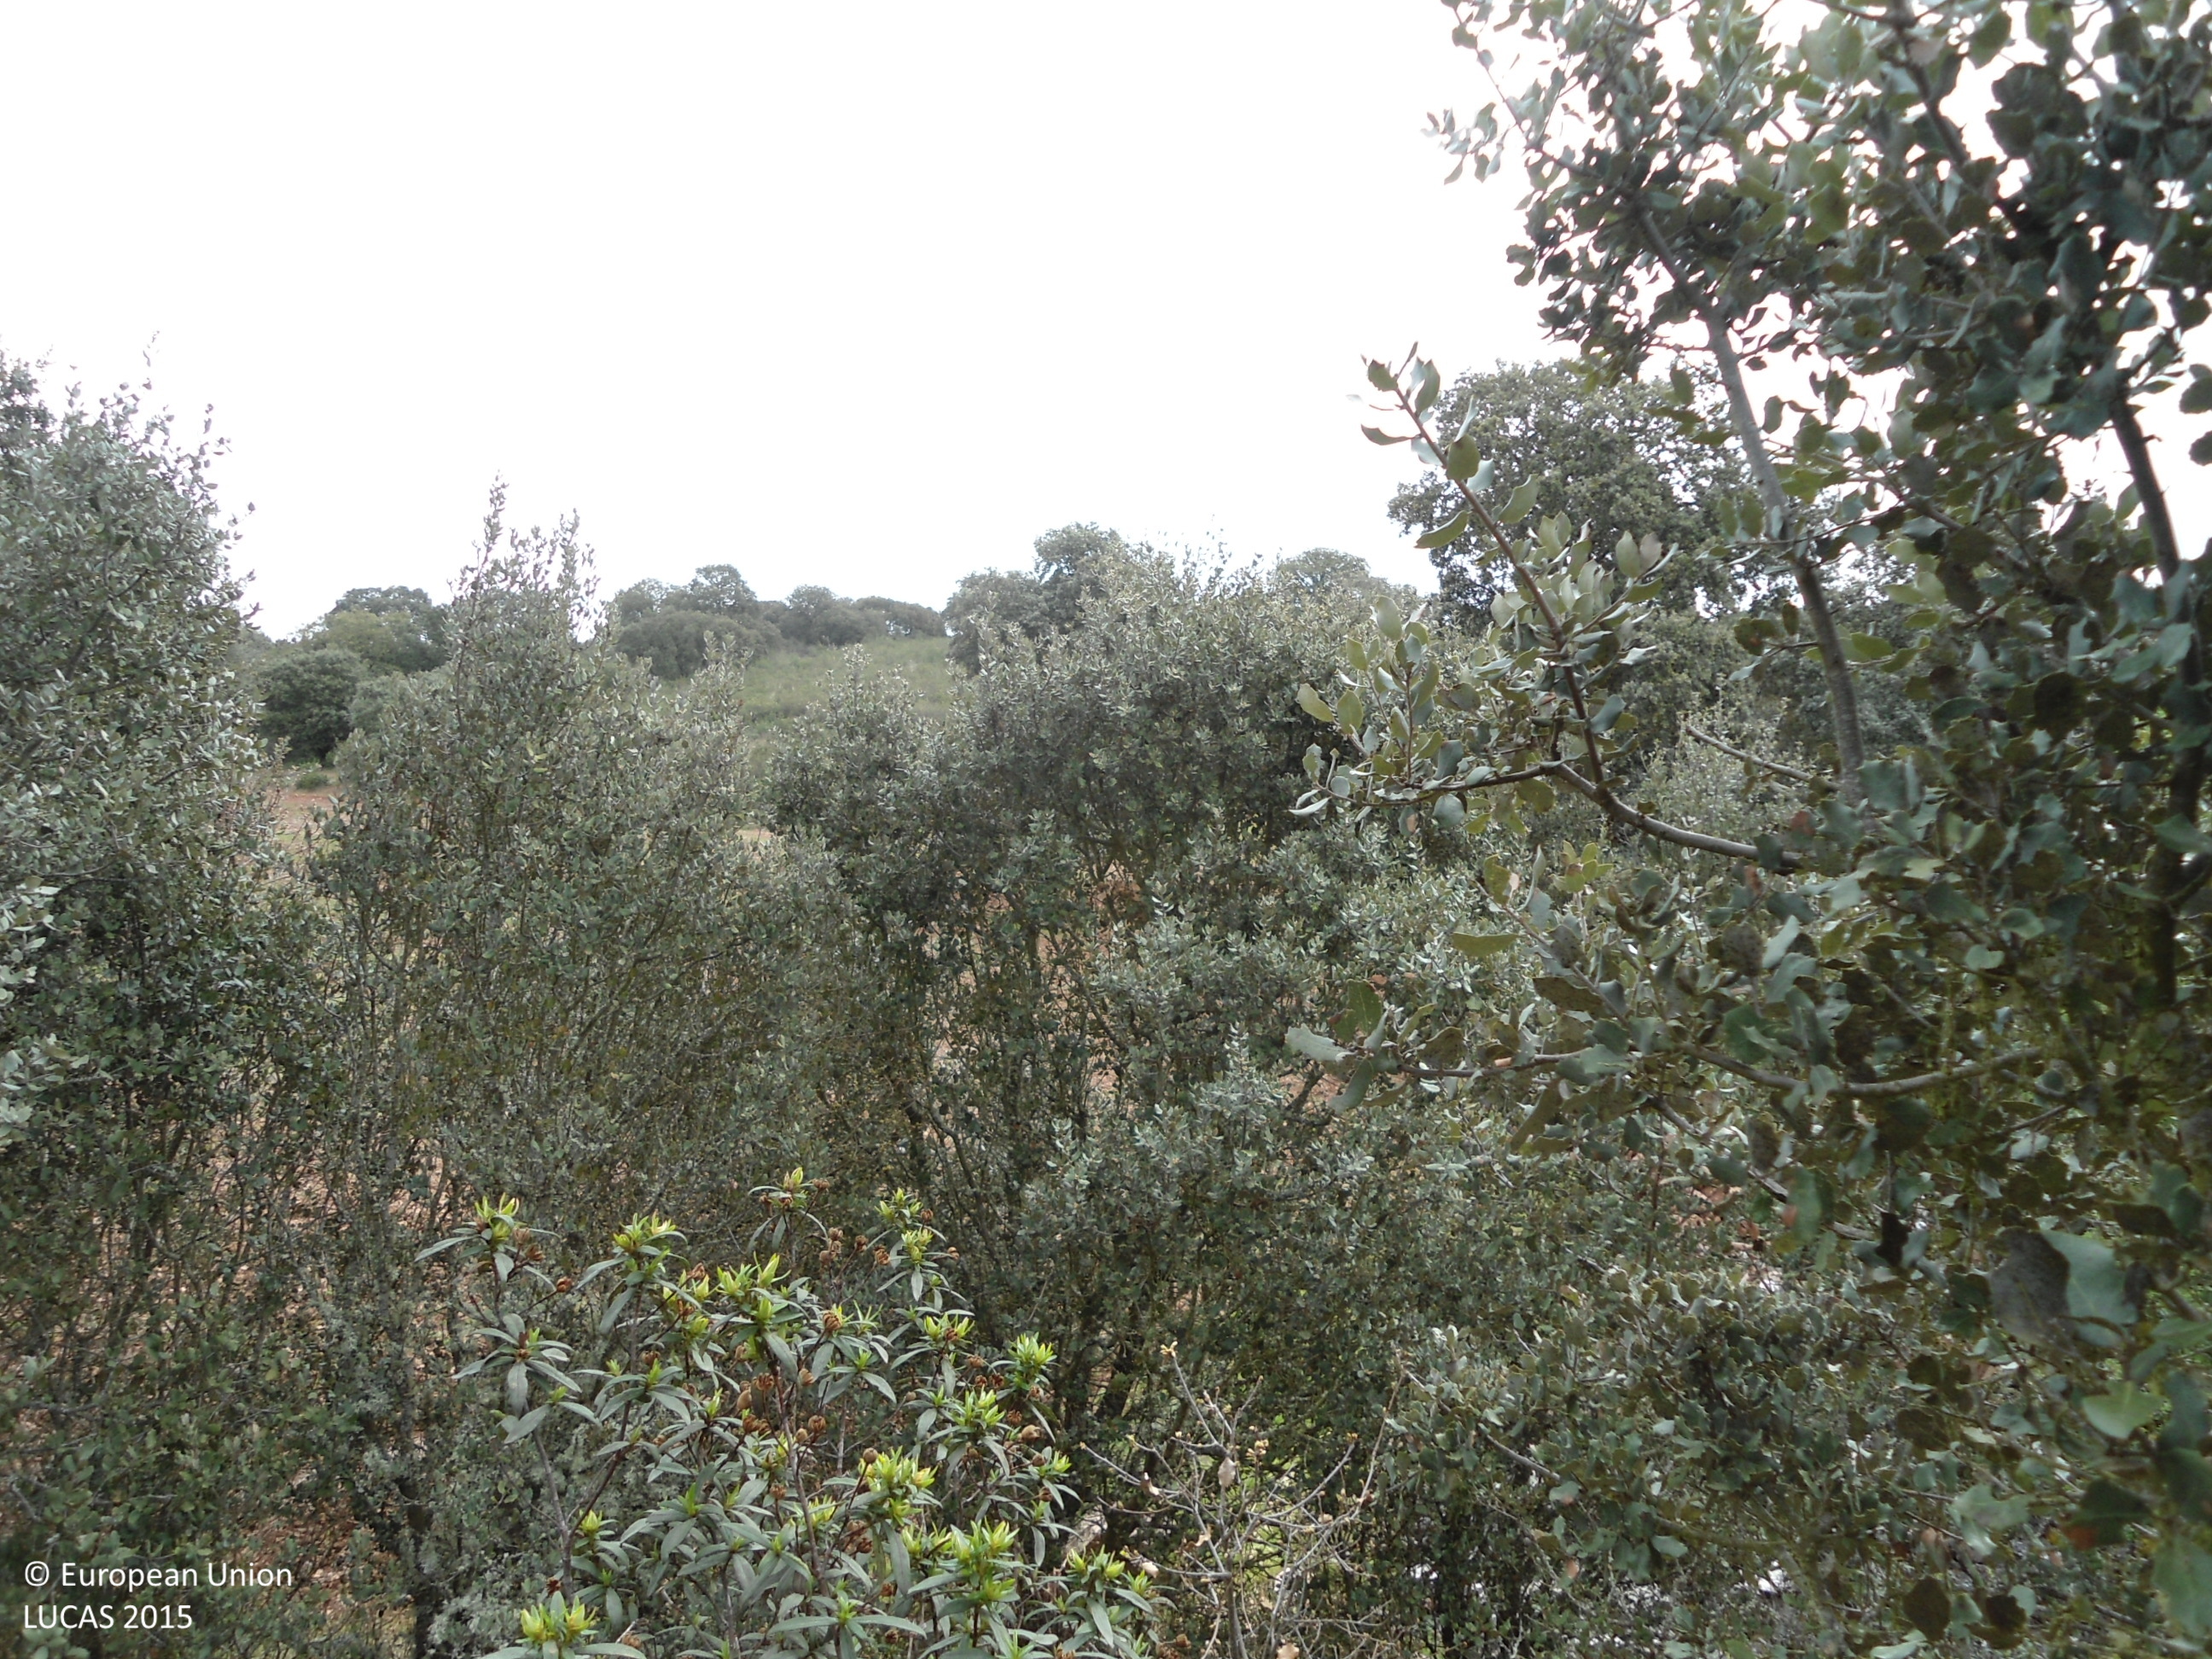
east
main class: Woodland
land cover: Broadleaved woodland
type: acidophilous oak and oak-birch forest
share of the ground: 50 - 75 %
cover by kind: broadleaved forest trees 80 %, shrubs 20 %
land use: Forestry
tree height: < 5 m
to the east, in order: Broadleaved woodland; Grassland with sparse tree/shrub cover; Rock outcrops; Broadleaved woodland
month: April
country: ES
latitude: 41.5357
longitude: -5.8997
